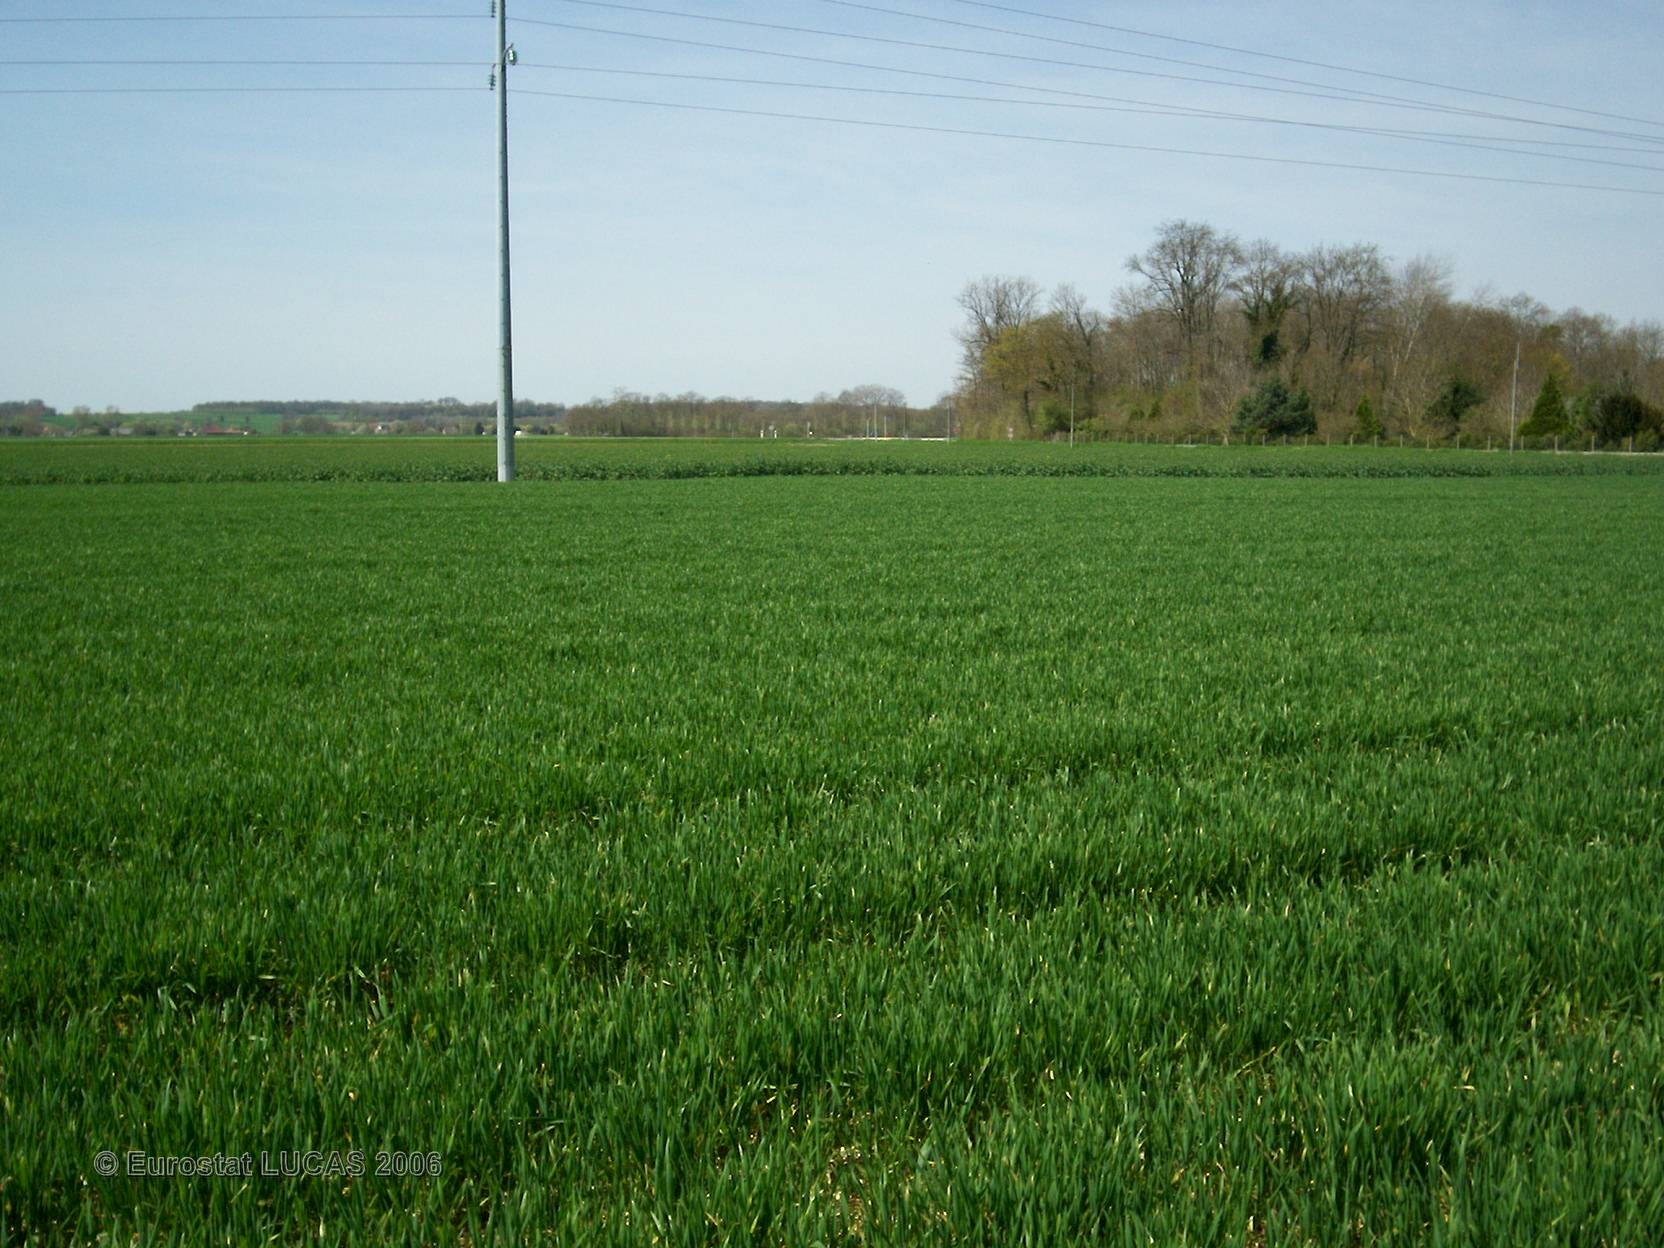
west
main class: Cropland
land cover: Common wheat
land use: Agriculture (excluding fallow land and kitchen gardens)
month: April
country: FR
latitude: 48.4122
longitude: 4.5257
